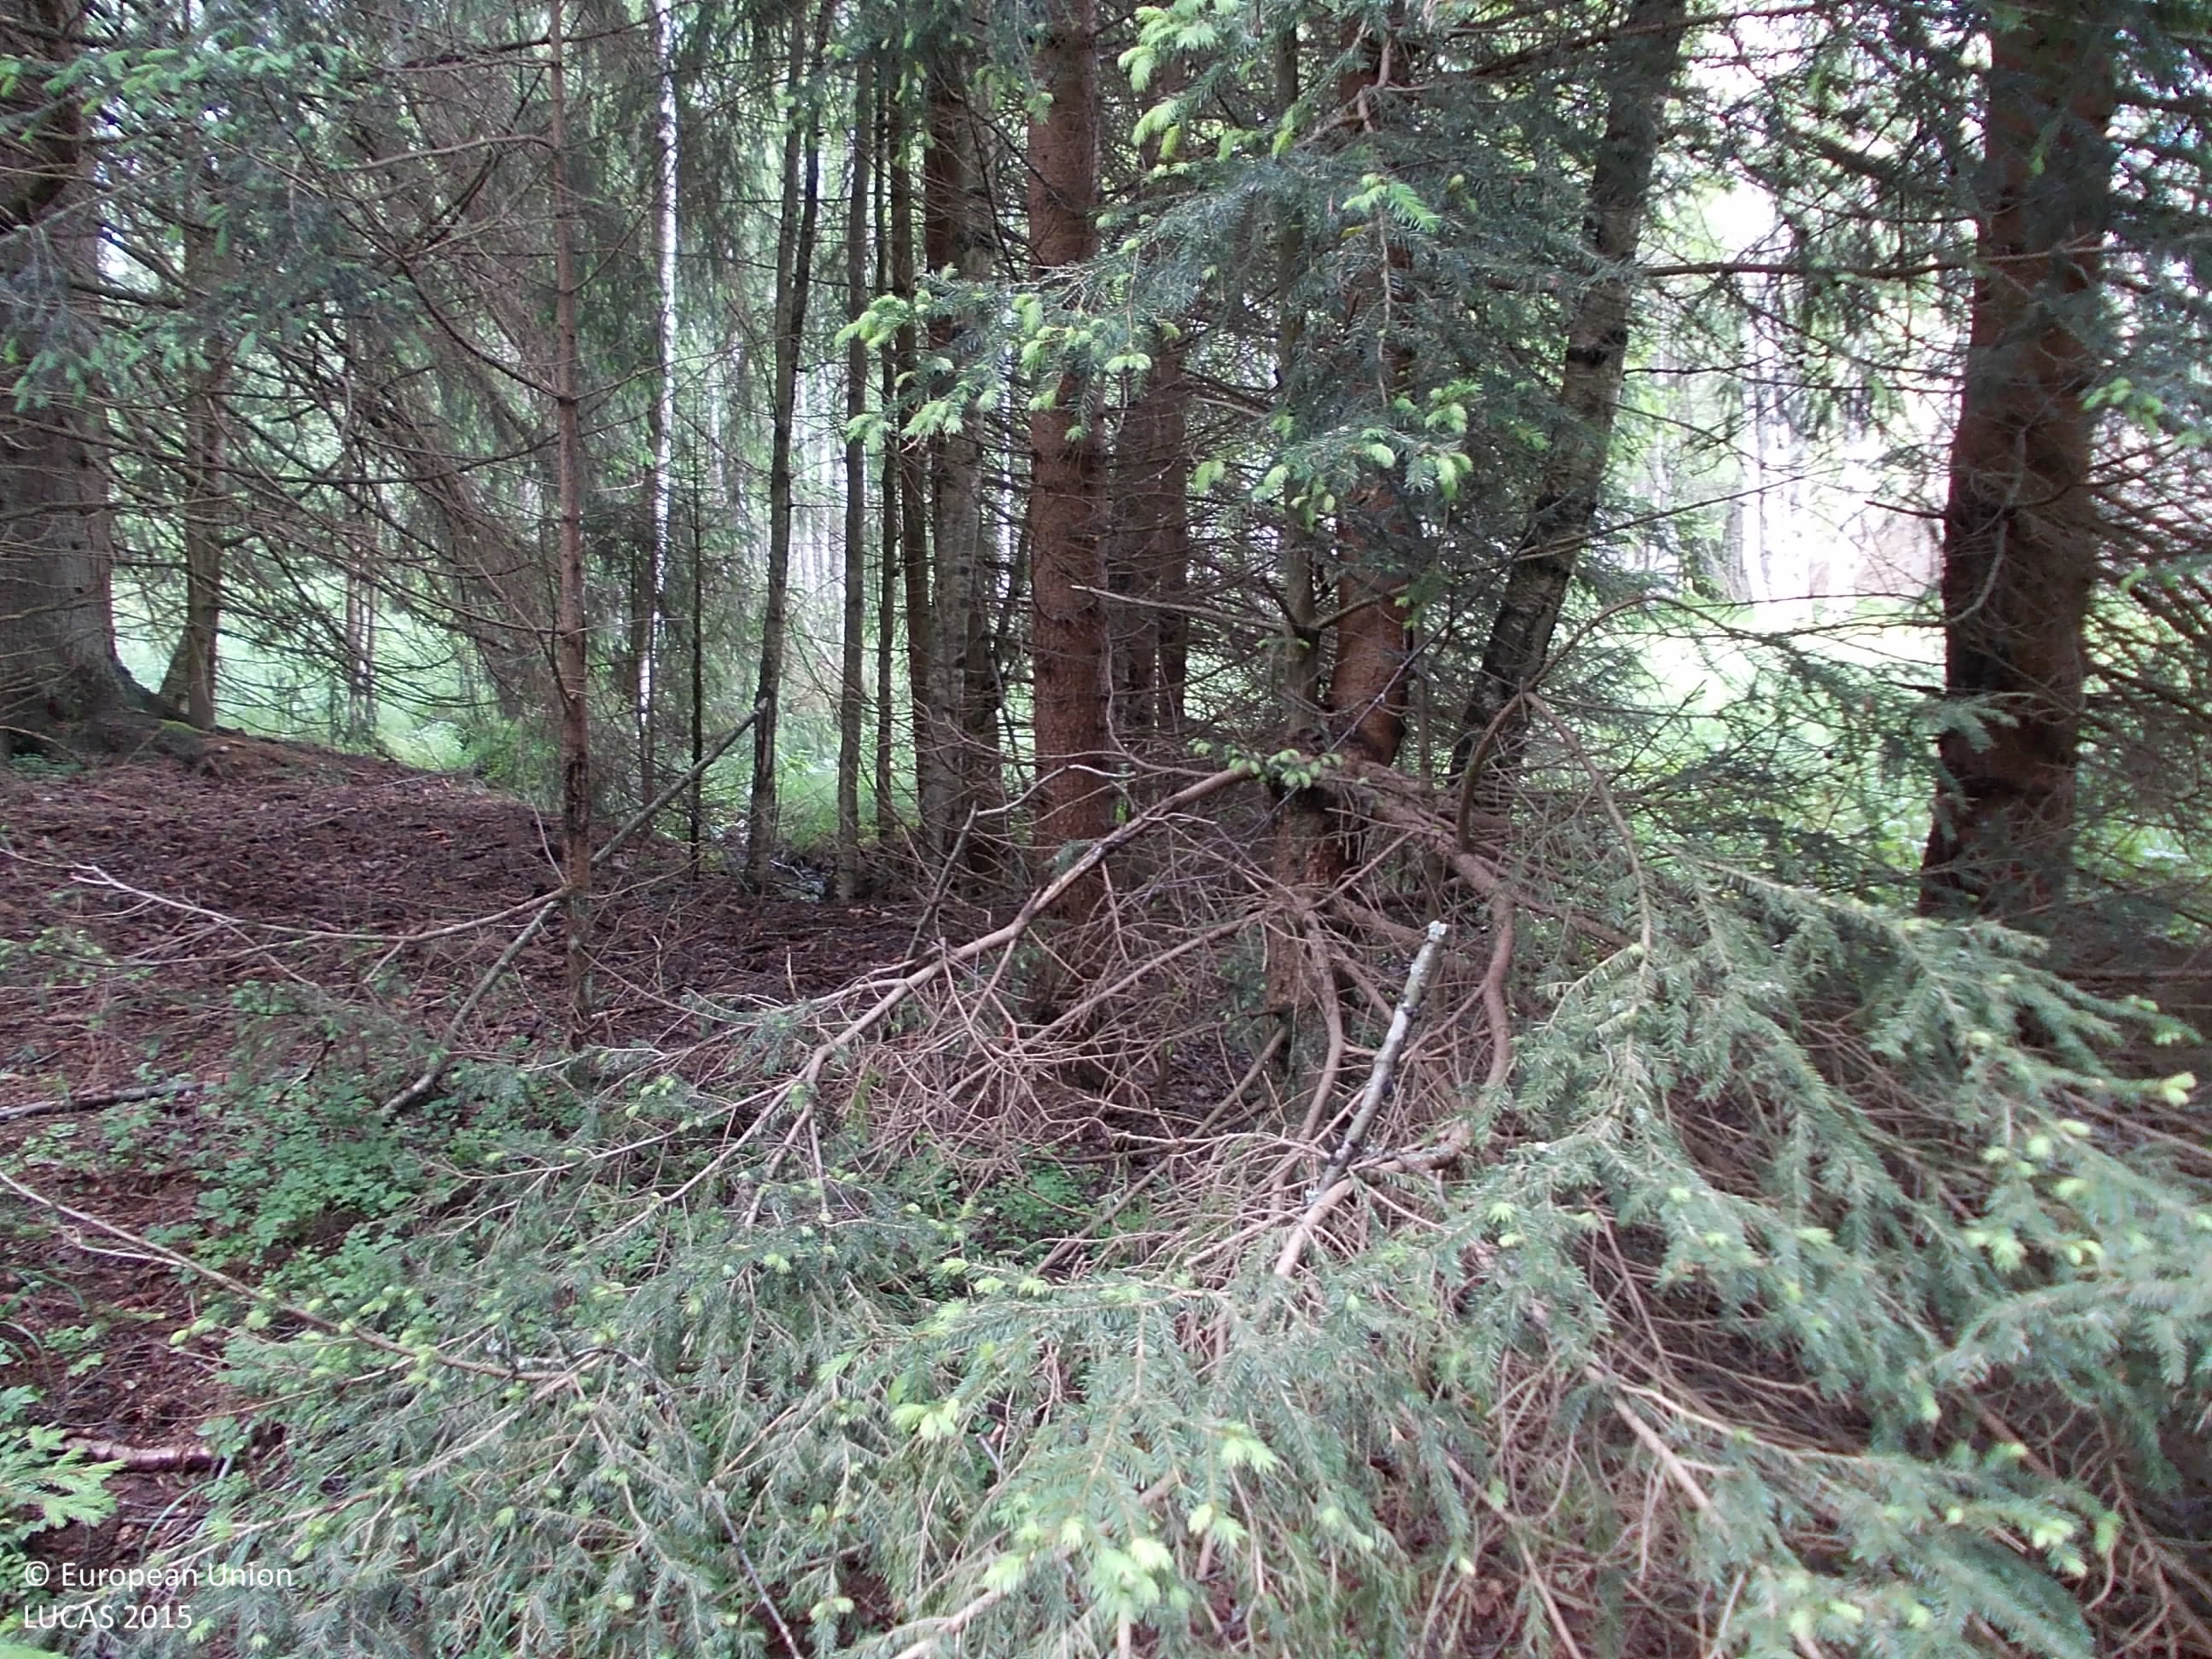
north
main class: Woodland
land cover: Spruce dominated mixed woodland
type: hemiboreal forest and nemoral coniferous forest and mixed broadleaved-coniferous forest
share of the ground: 50 - 75 %
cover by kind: coniferous forest trees 40 %, herbaceous plants 40 %, broadleaved forest trees 20 %
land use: Forestry
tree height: > 5 m
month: June
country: CZ
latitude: 48.8821
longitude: 13.6955
